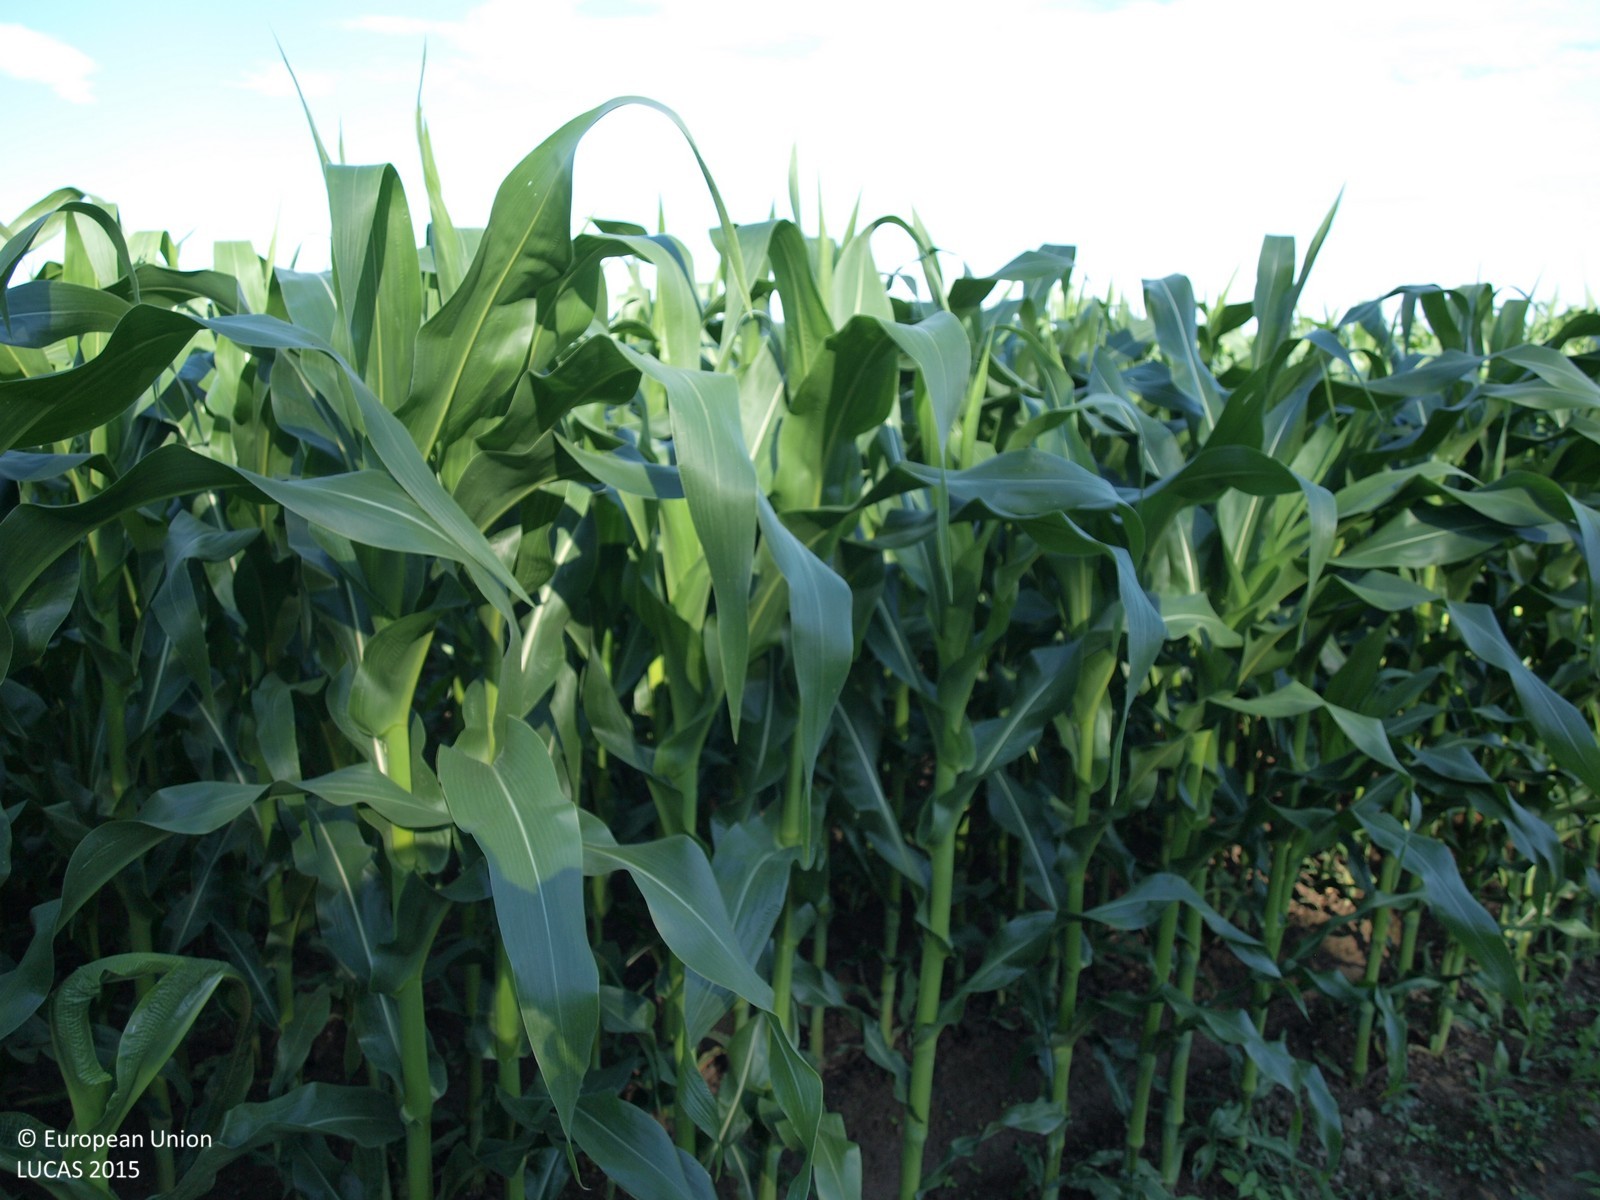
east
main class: Cropland
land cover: Other fresh vegetables
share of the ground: 50 - 75 %
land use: Agriculture (excluding fallow land and kitchen gardens)
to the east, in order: Other fresh vegetables; Maize; Other fresh vegetables; Tracks; Maize
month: June
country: HR
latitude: 46.2849
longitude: 16.7114
